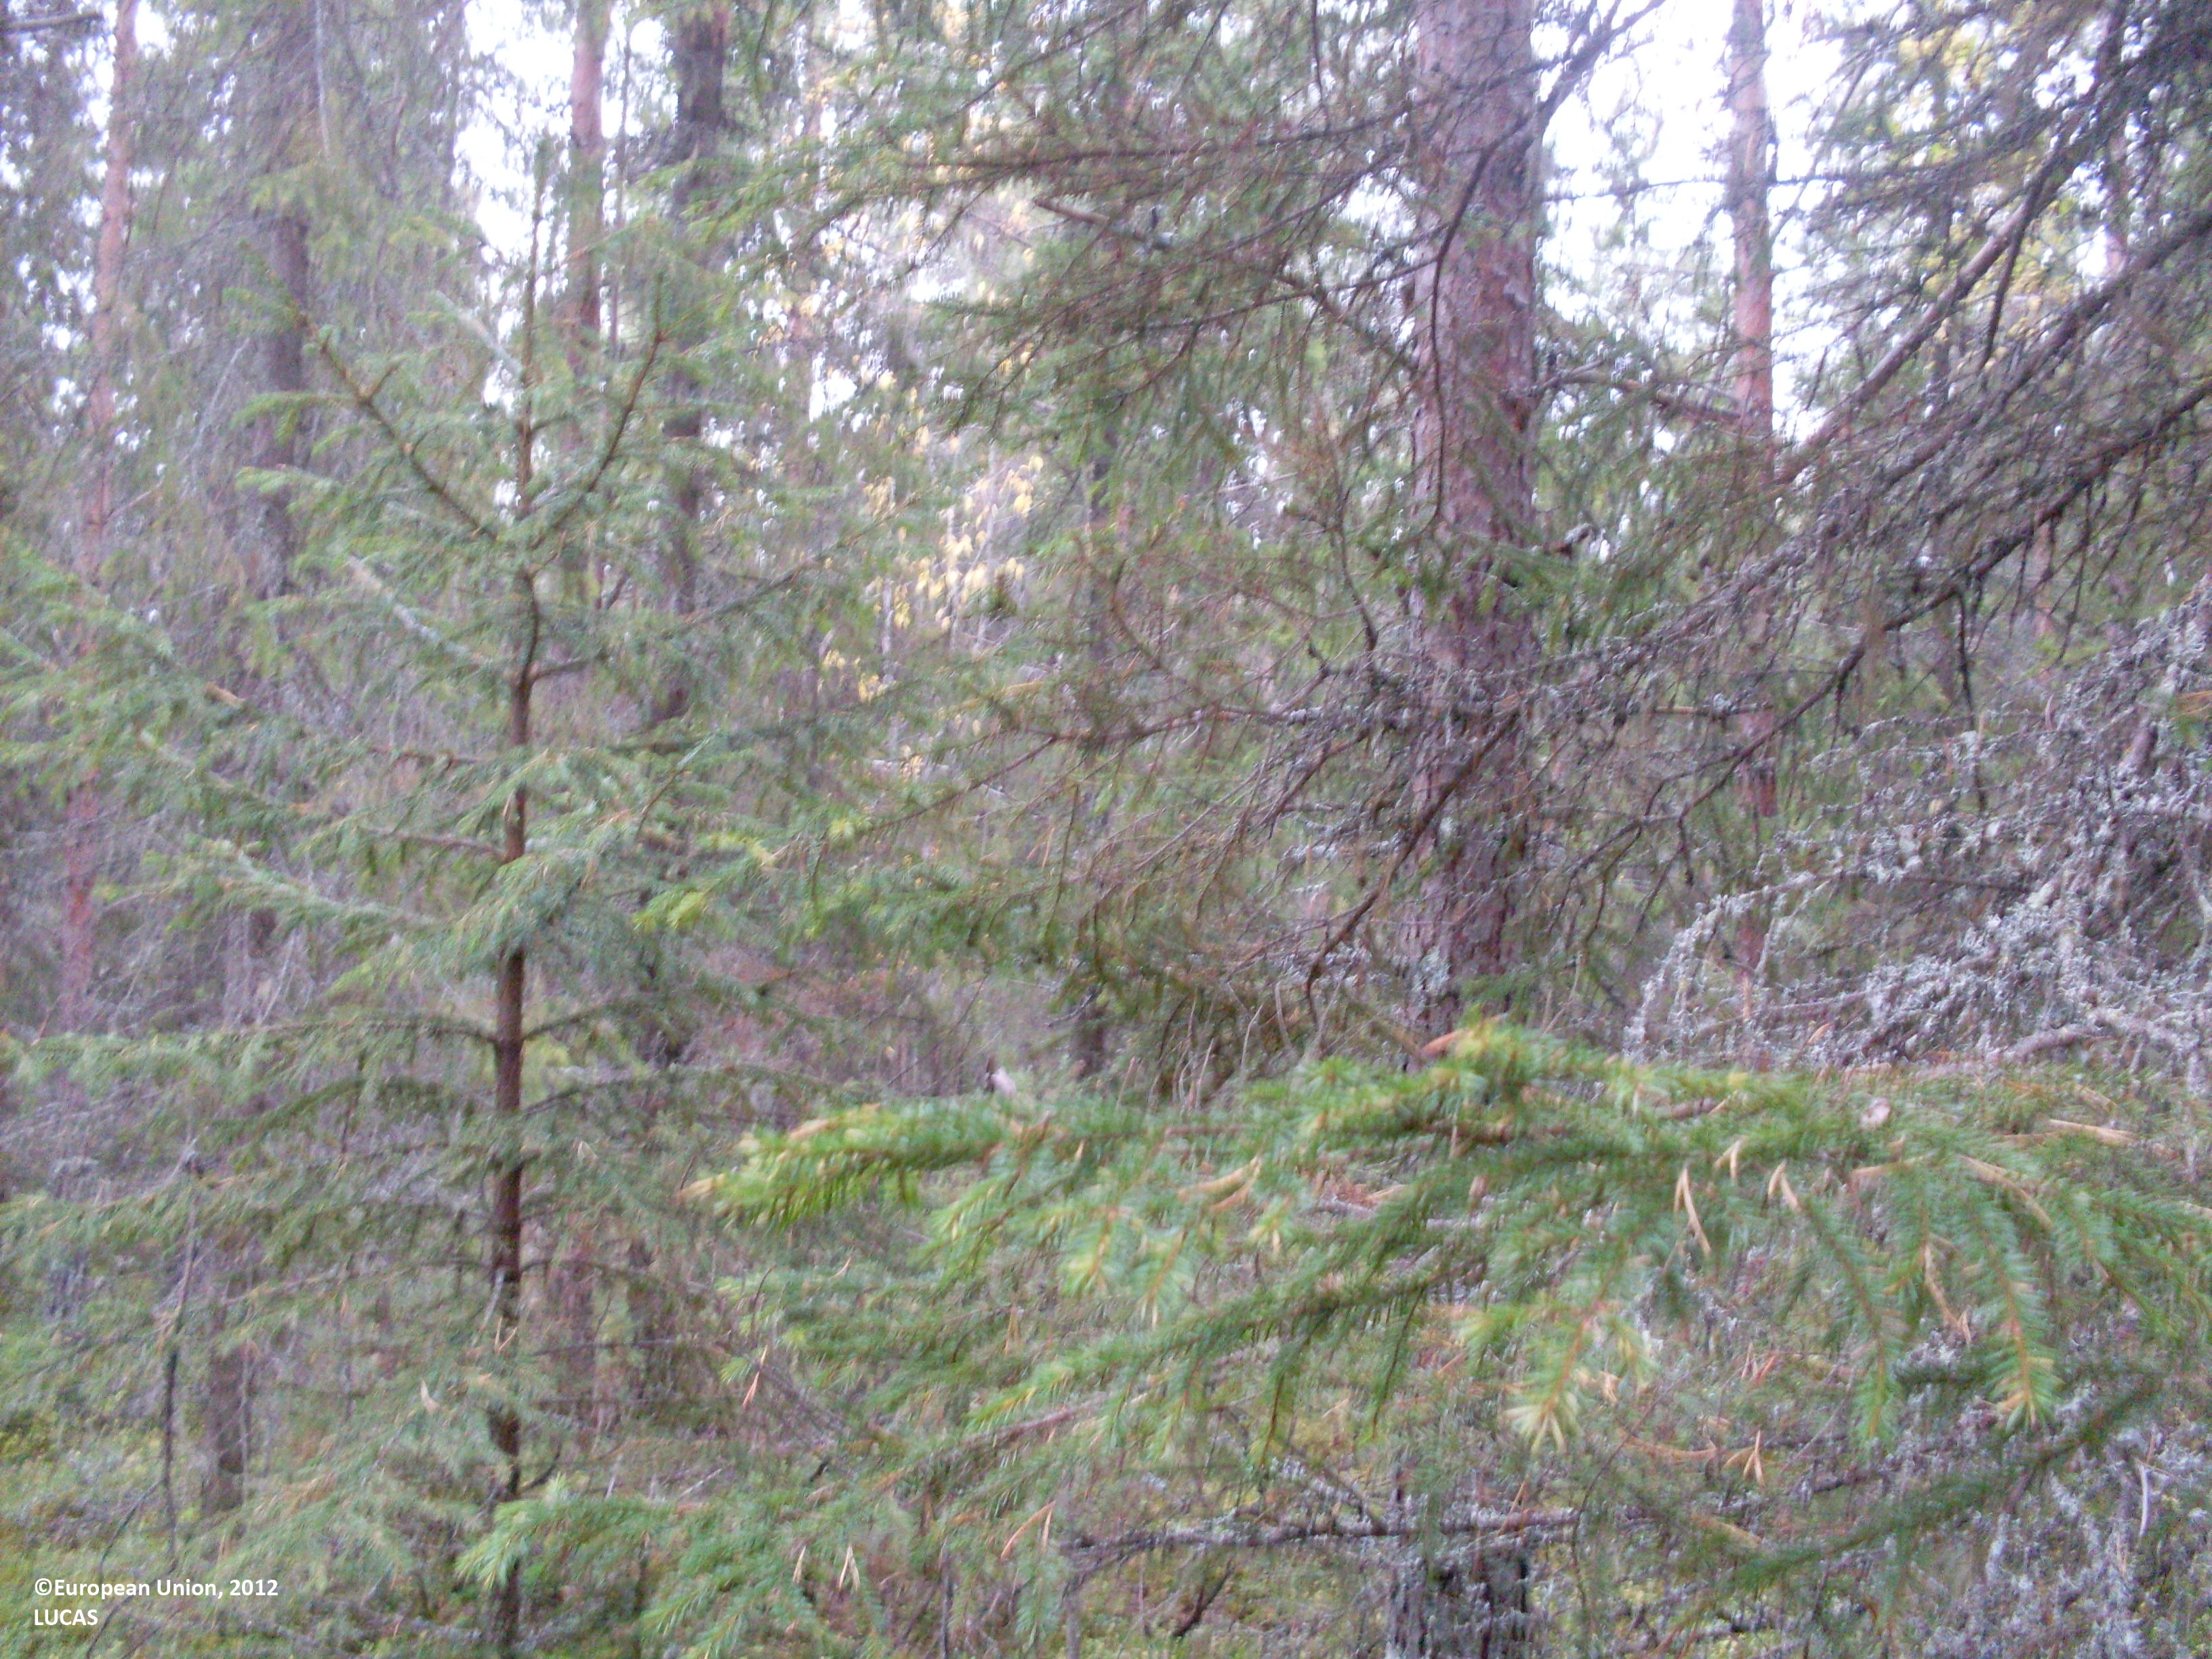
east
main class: Woodland
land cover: Spruce dominated coniferous woodland
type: boreal forest
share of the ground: 50 - 75 %
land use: Forestry
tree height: > 5 m
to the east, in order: Spruce dominated coniferous woodland; Rivers and streams; Spruce dominated mixed woodland; Pine dominated mixed woodland; Pine dominated coniferous woodland
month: September
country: FI
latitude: 64.4364
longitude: 28.4747
